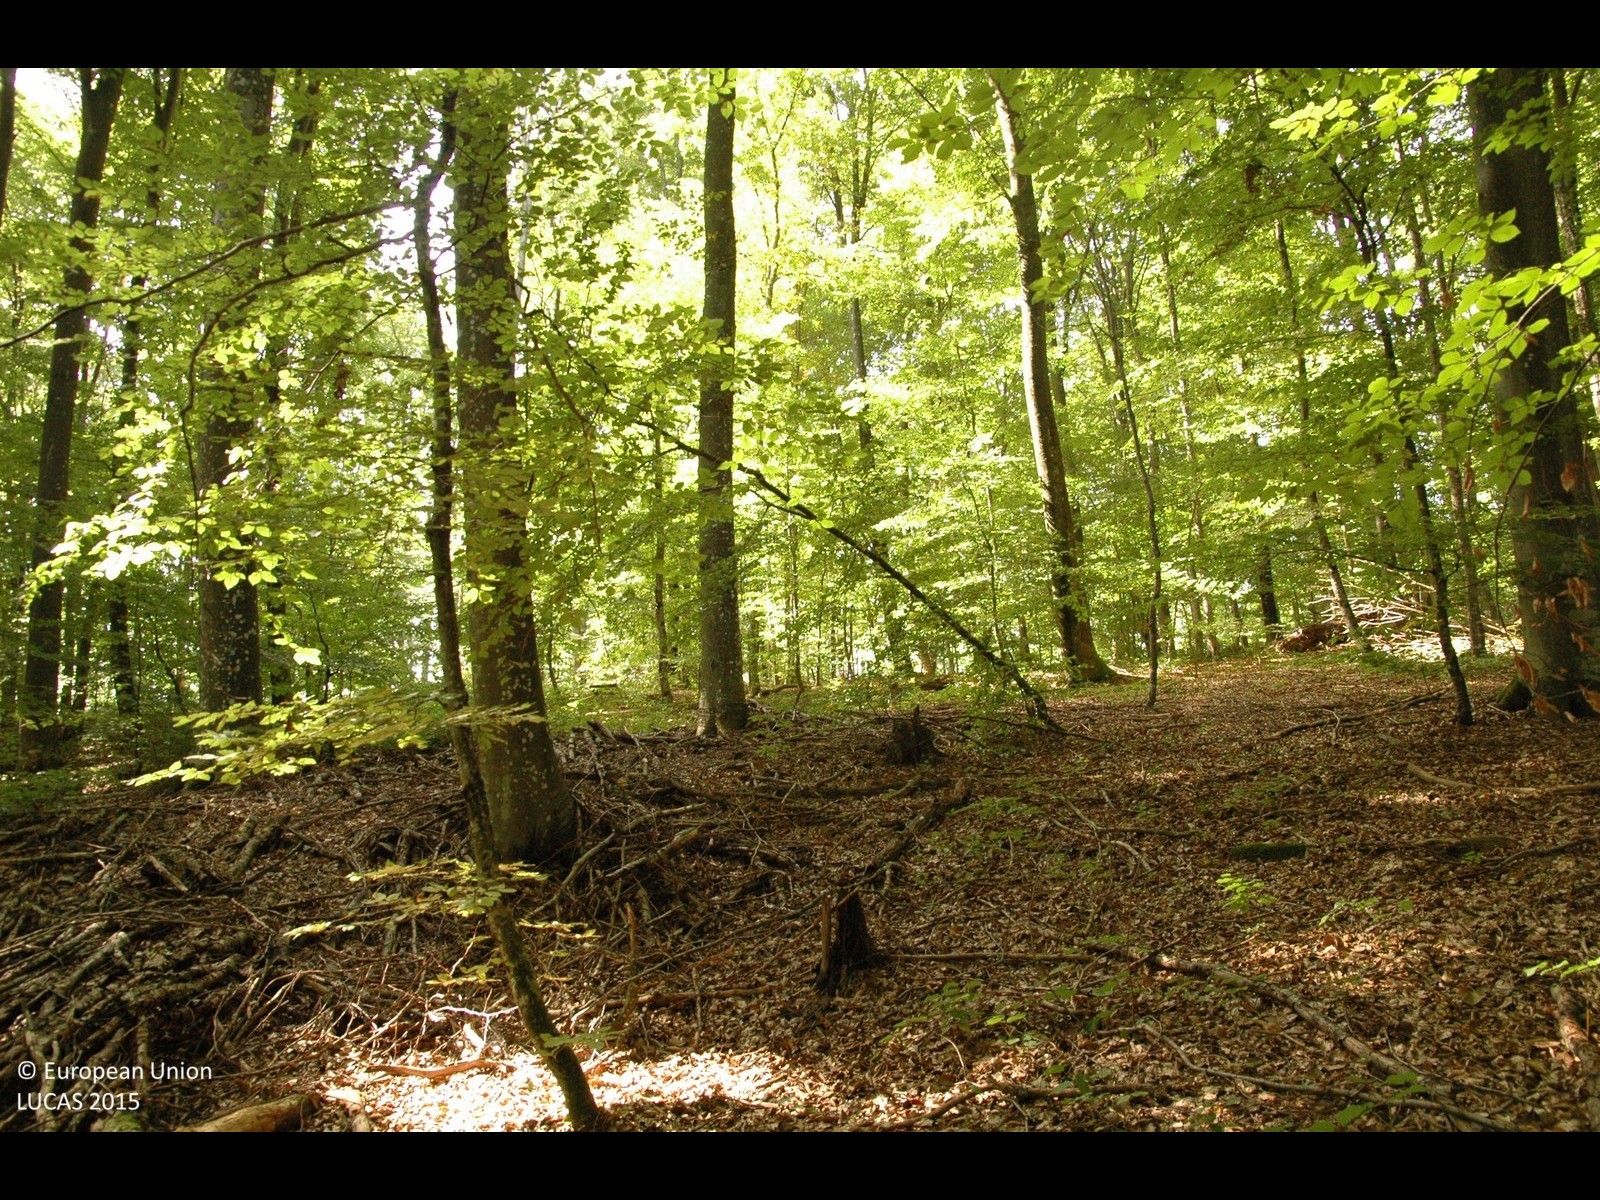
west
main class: Woodland
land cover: Broadleaved woodland
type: beech forest
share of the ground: > 75 %
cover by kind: broadleaved forest trees 100 %
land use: Forestry
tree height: > 5 m
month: September
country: HR
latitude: 45.5934
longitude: 15.8809
